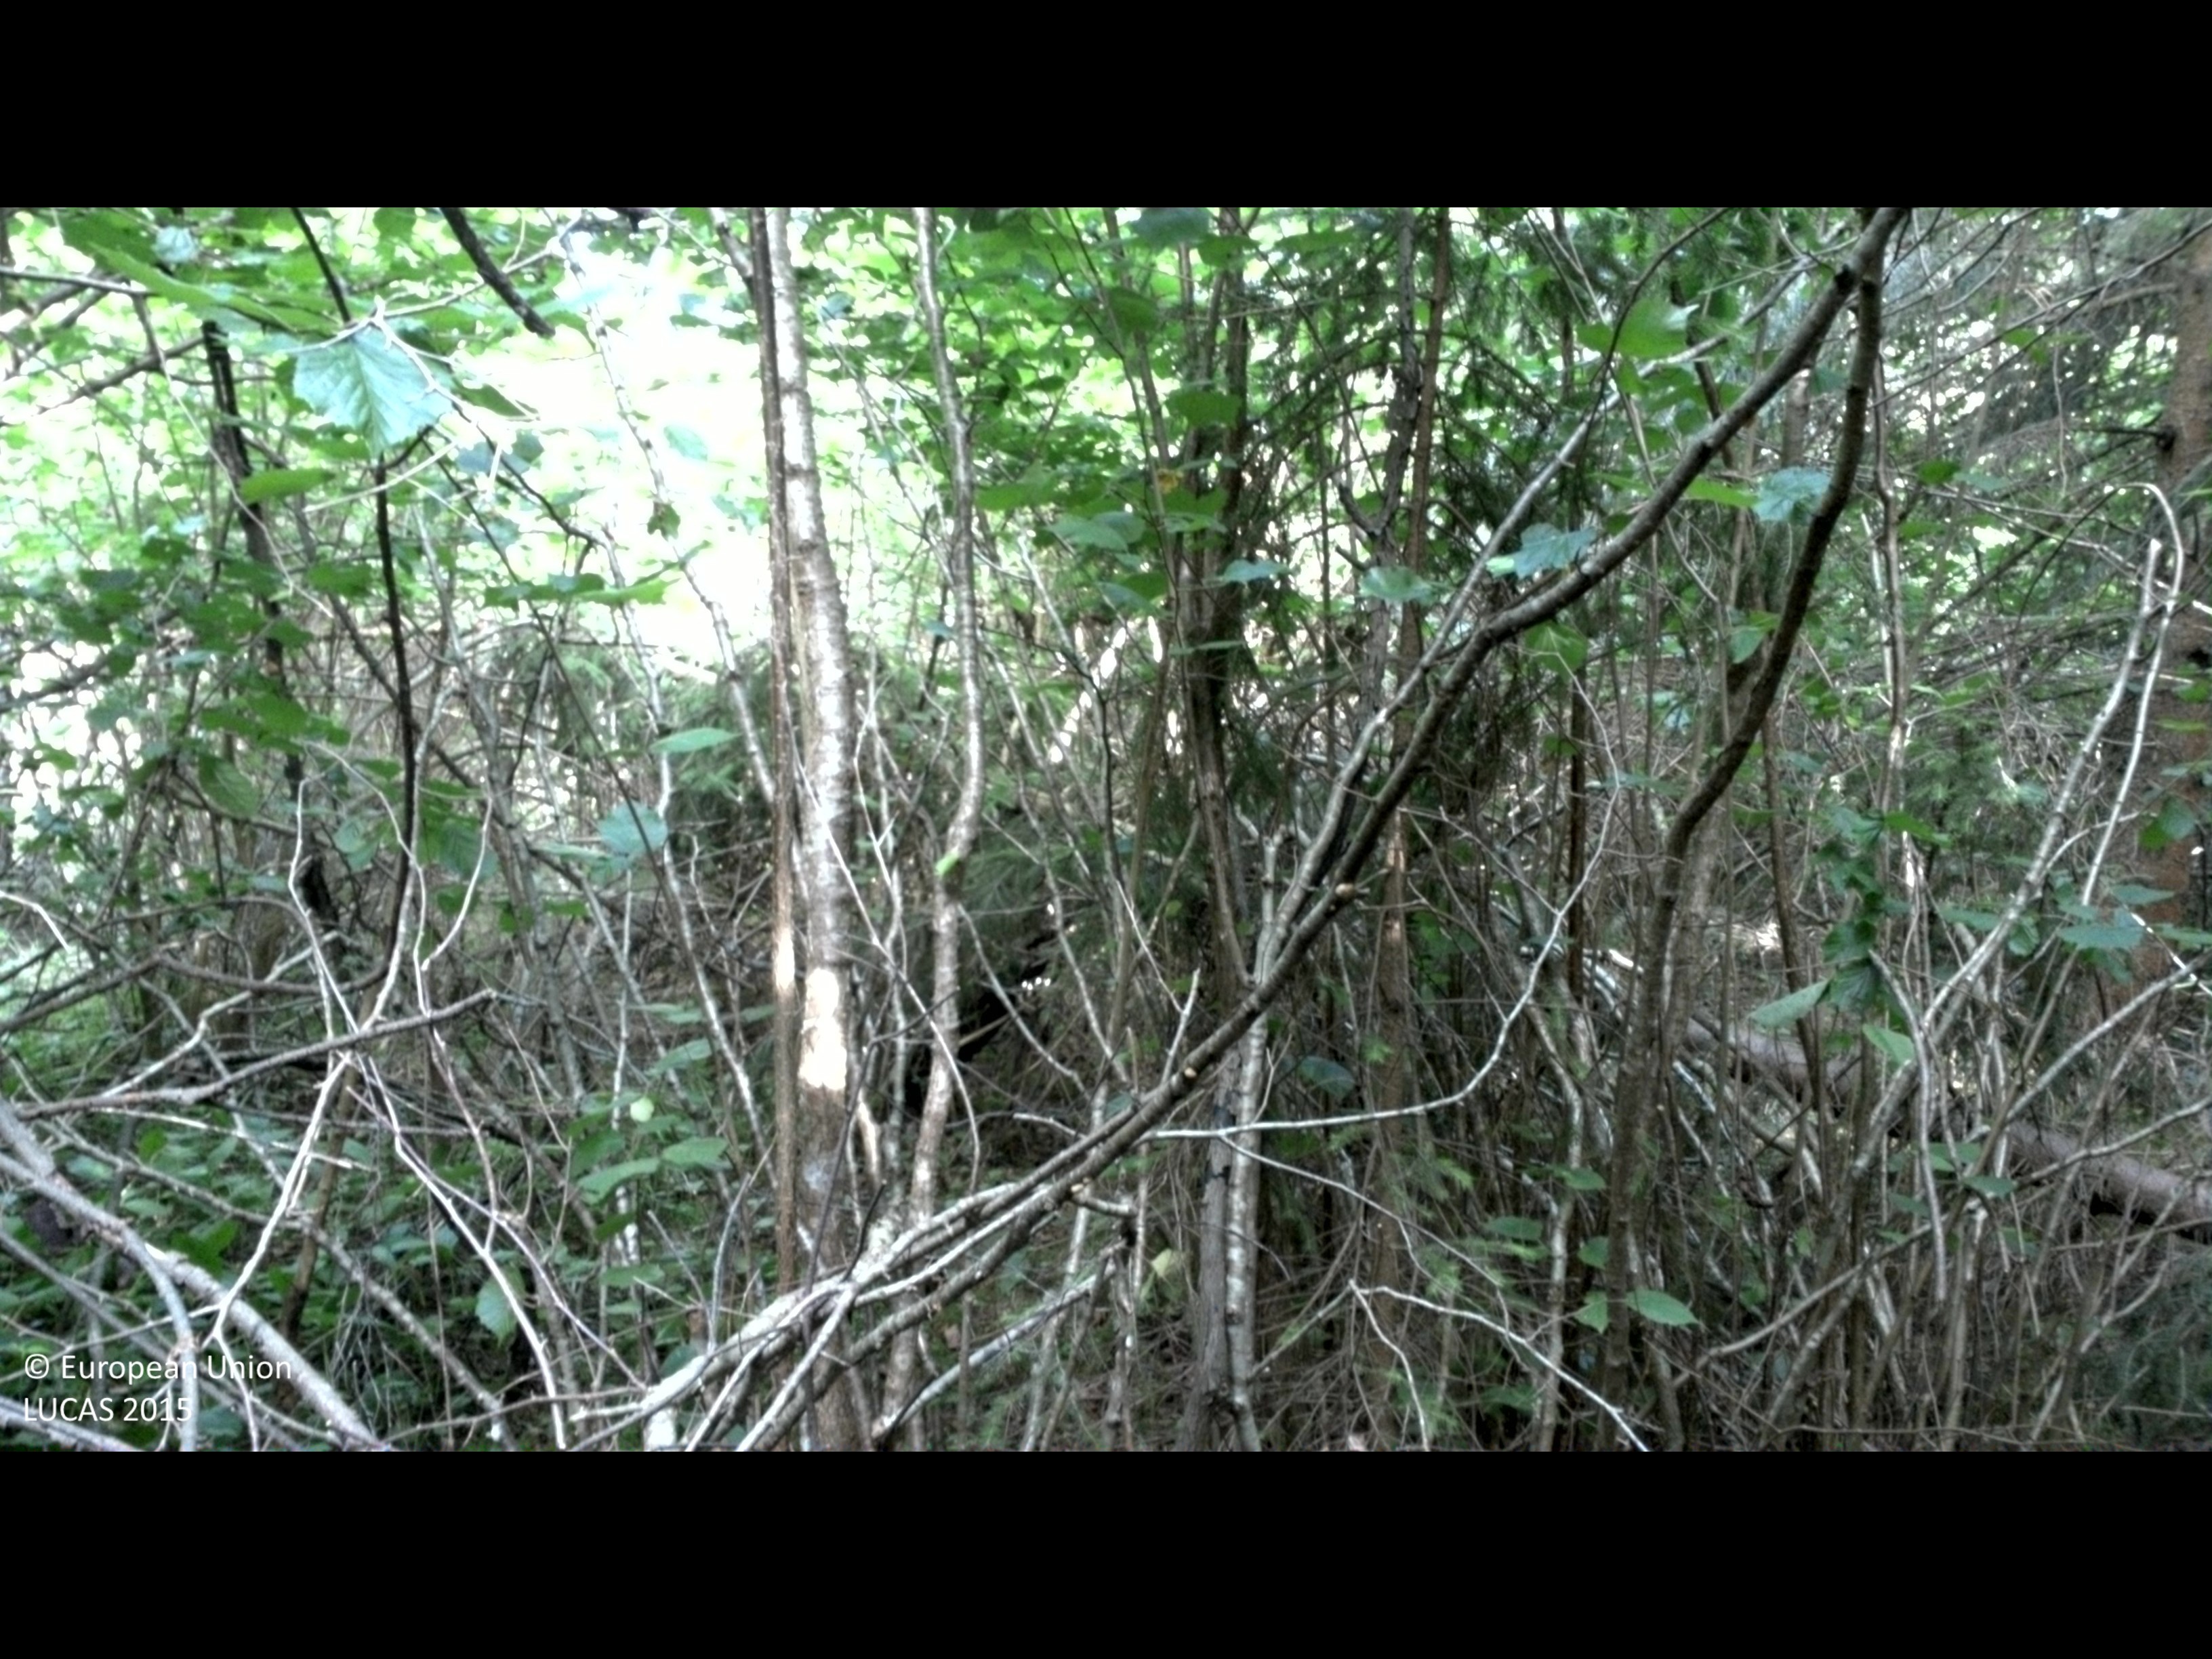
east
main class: Shrubland
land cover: Shrubland with sparse tree cover
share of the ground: > 75 %
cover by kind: shrubs 95 %, broadleaved forest trees 5 %
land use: Semi-natural and natural areas not in use
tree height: > 5 m
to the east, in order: Shrubland with sparse tree cover; Pine dominated coniferous woodland; Shrubland with sparse tree cover; Inland marshes; Shrubland with sparse tree cover
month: July
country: SE
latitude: 56.6491
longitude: 16.6071
